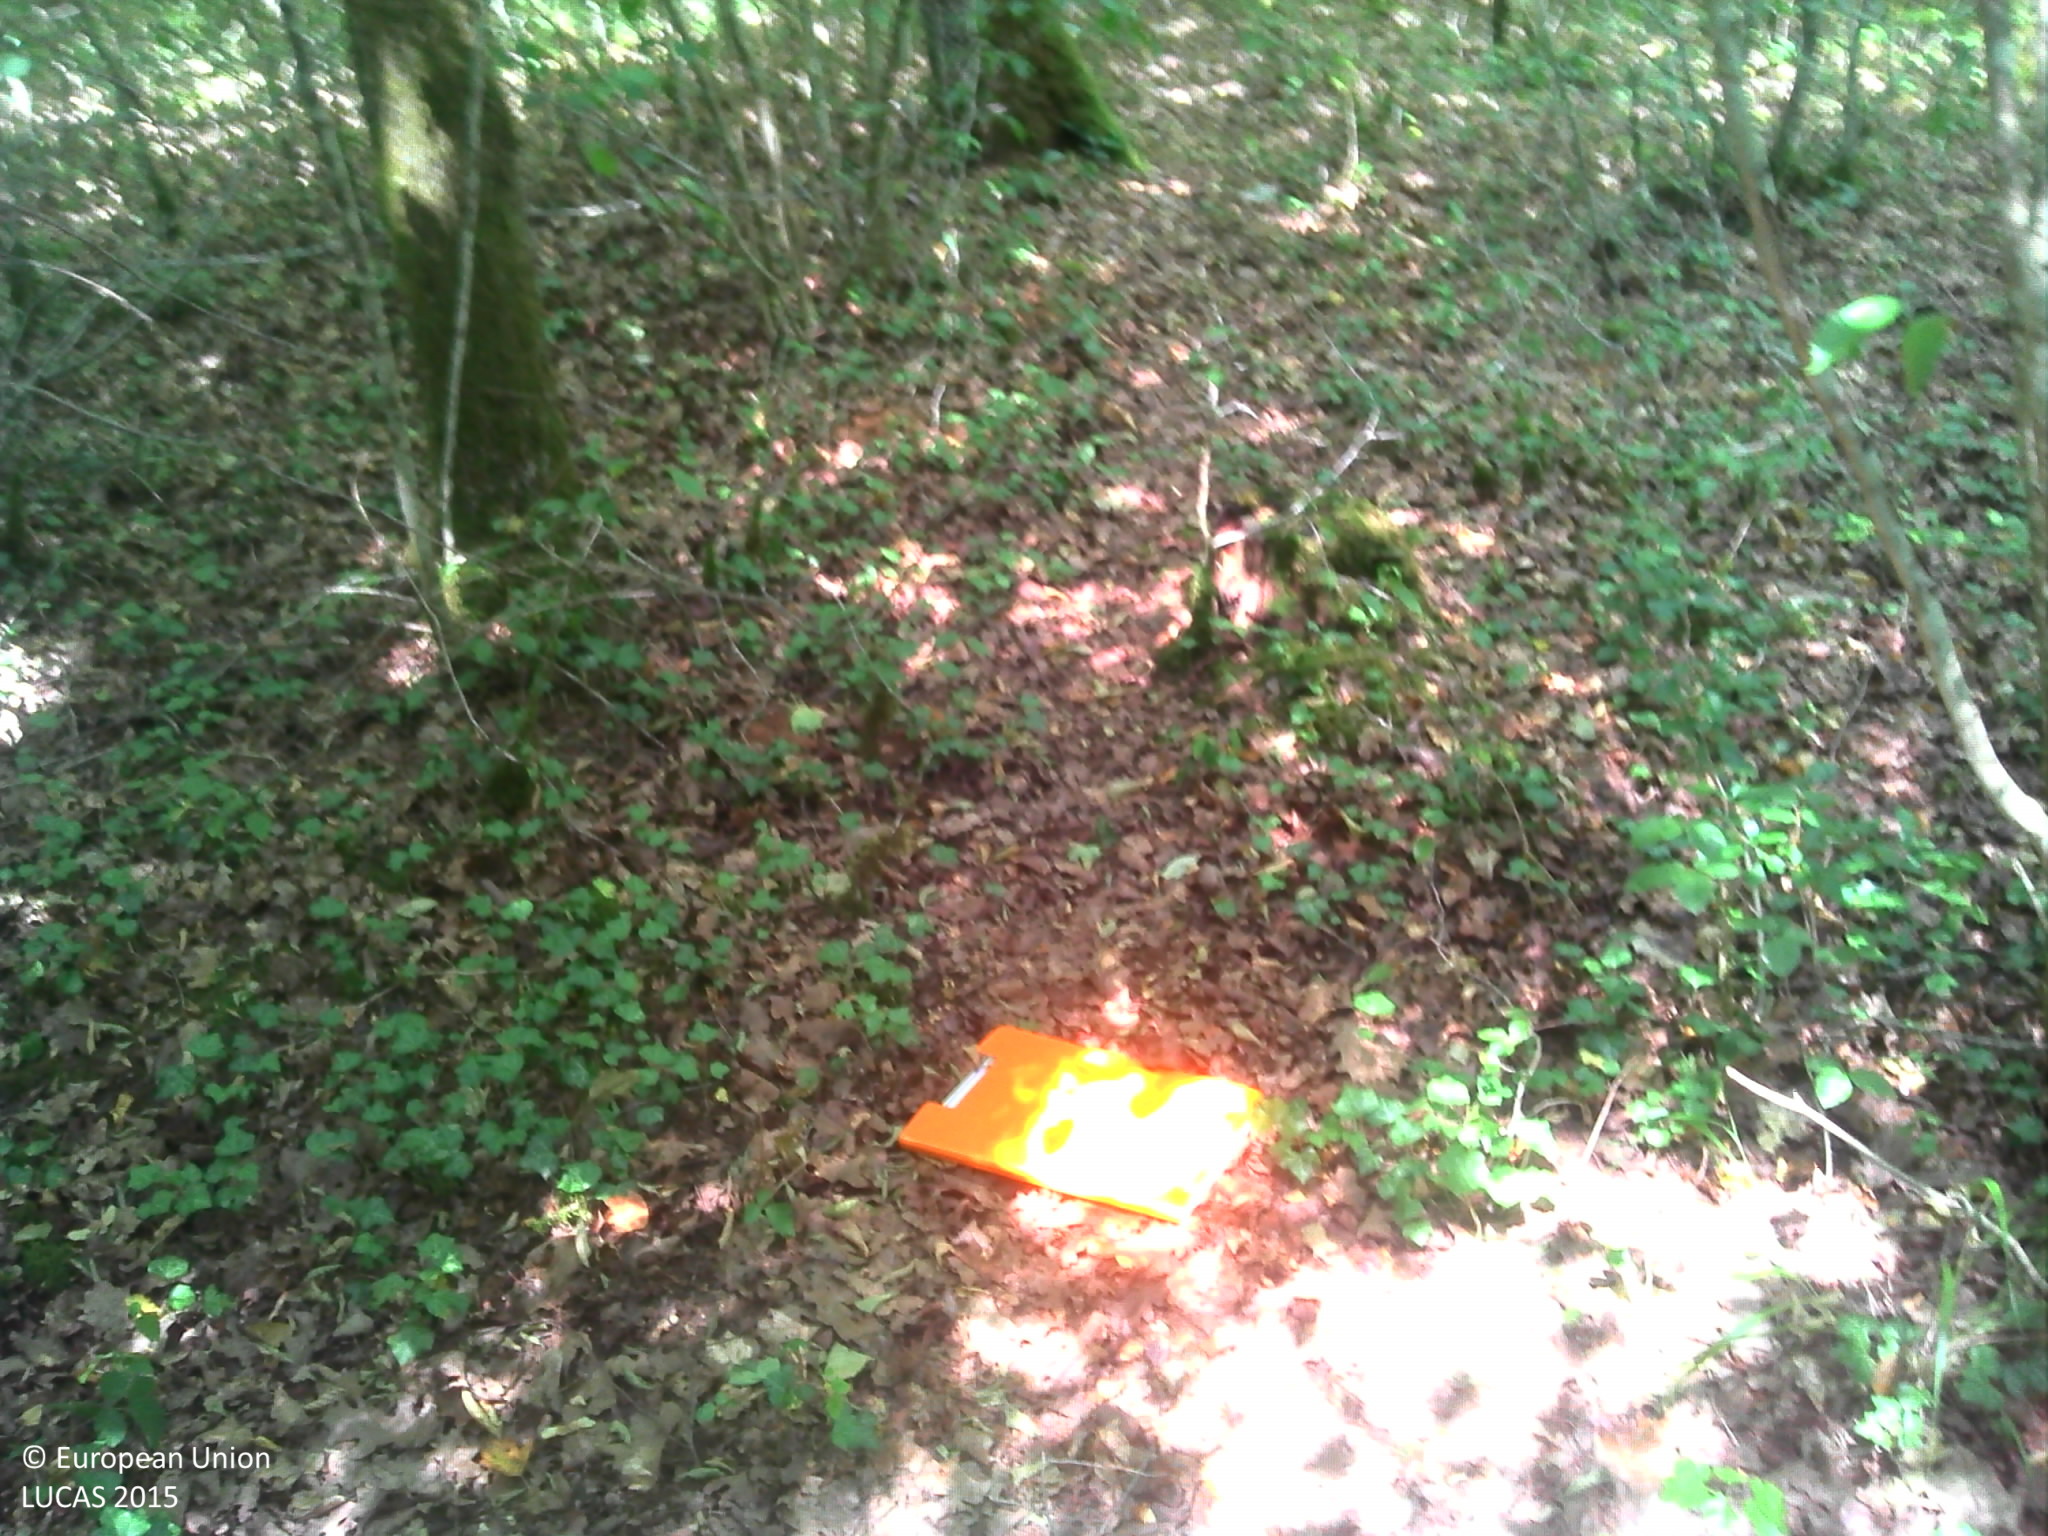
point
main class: Woodland
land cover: Broadleaved woodland
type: acidophilous oak and oak-birch forest
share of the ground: > 75 %
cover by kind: broadleaved forest trees 90 %, herbaceous plants 10 %
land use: Forestry
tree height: > 5 m
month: July
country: FR
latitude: 47.9432
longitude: 4.8983
